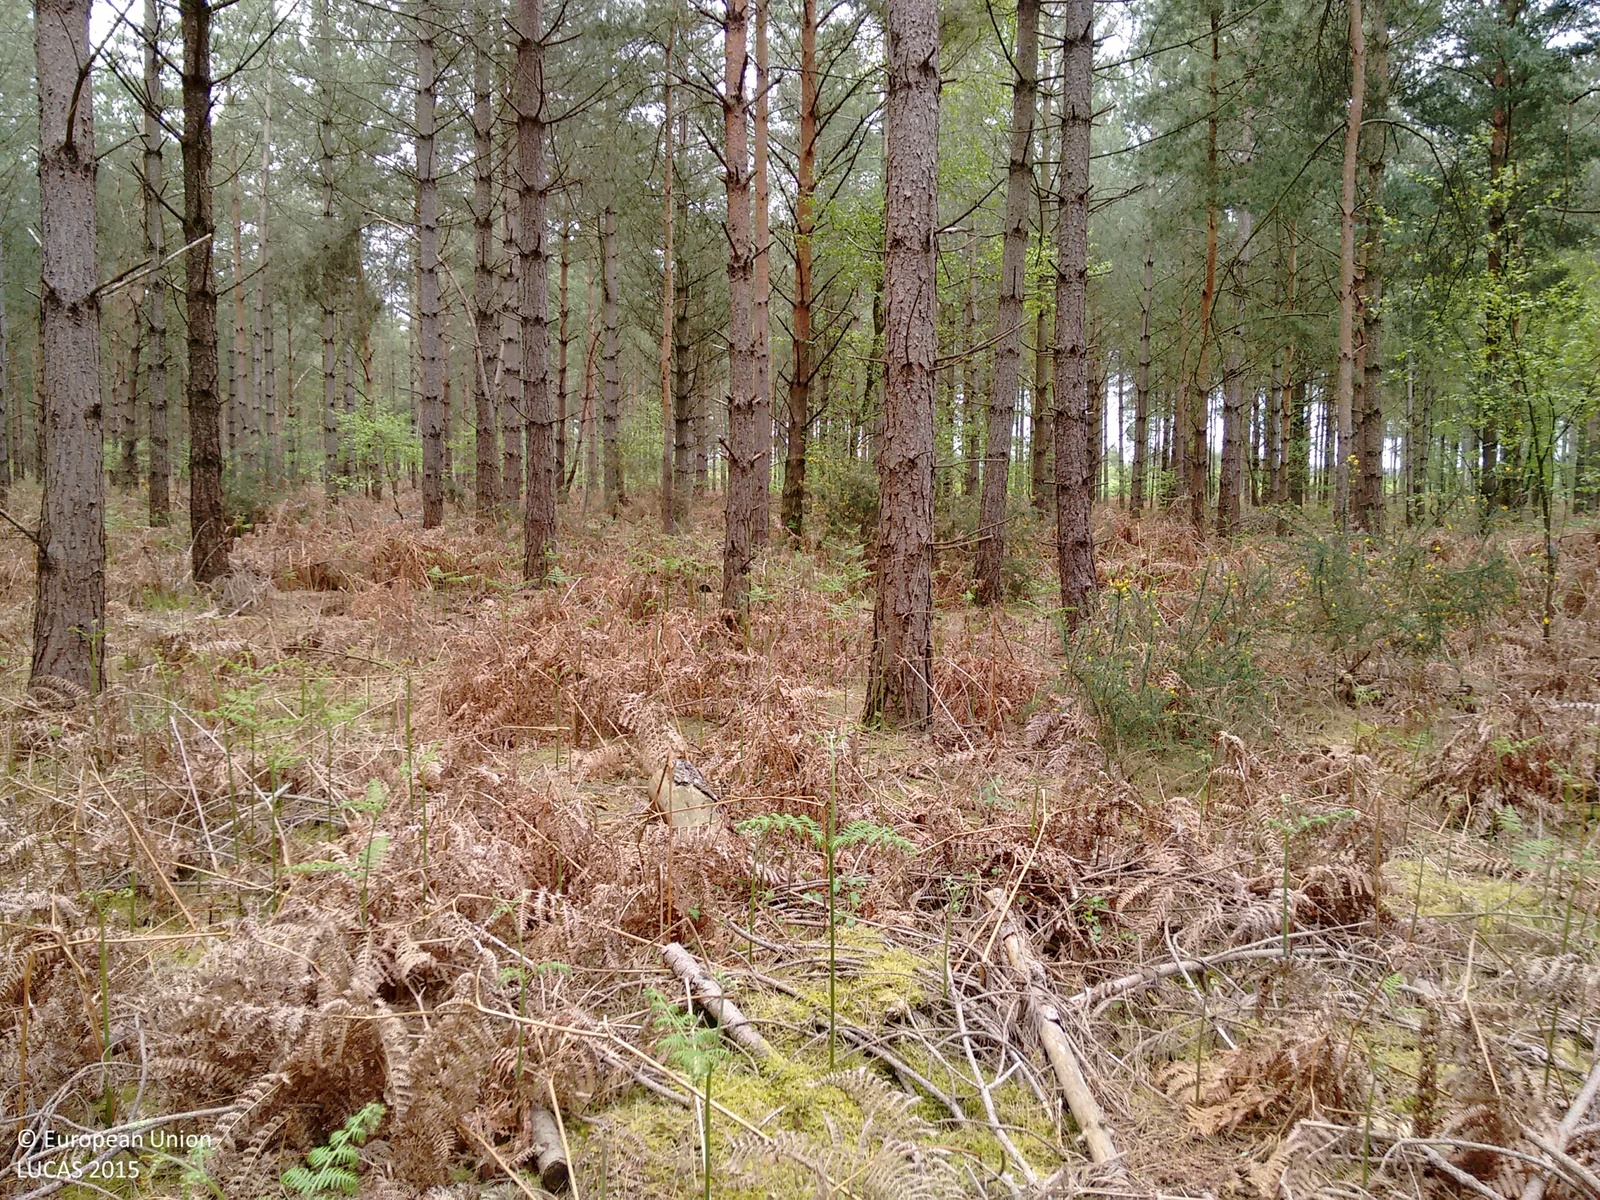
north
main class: Woodland
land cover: Pine dominated coniferous woodland
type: hemiboreal forest and nemoral coniferous forest and mixed broadleaved-coniferous forest
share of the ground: > 75 %
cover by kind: coniferous forest trees 100 %
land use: Forestry
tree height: > 5 m
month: May
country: GB
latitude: 50.8002
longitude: -1.8467
